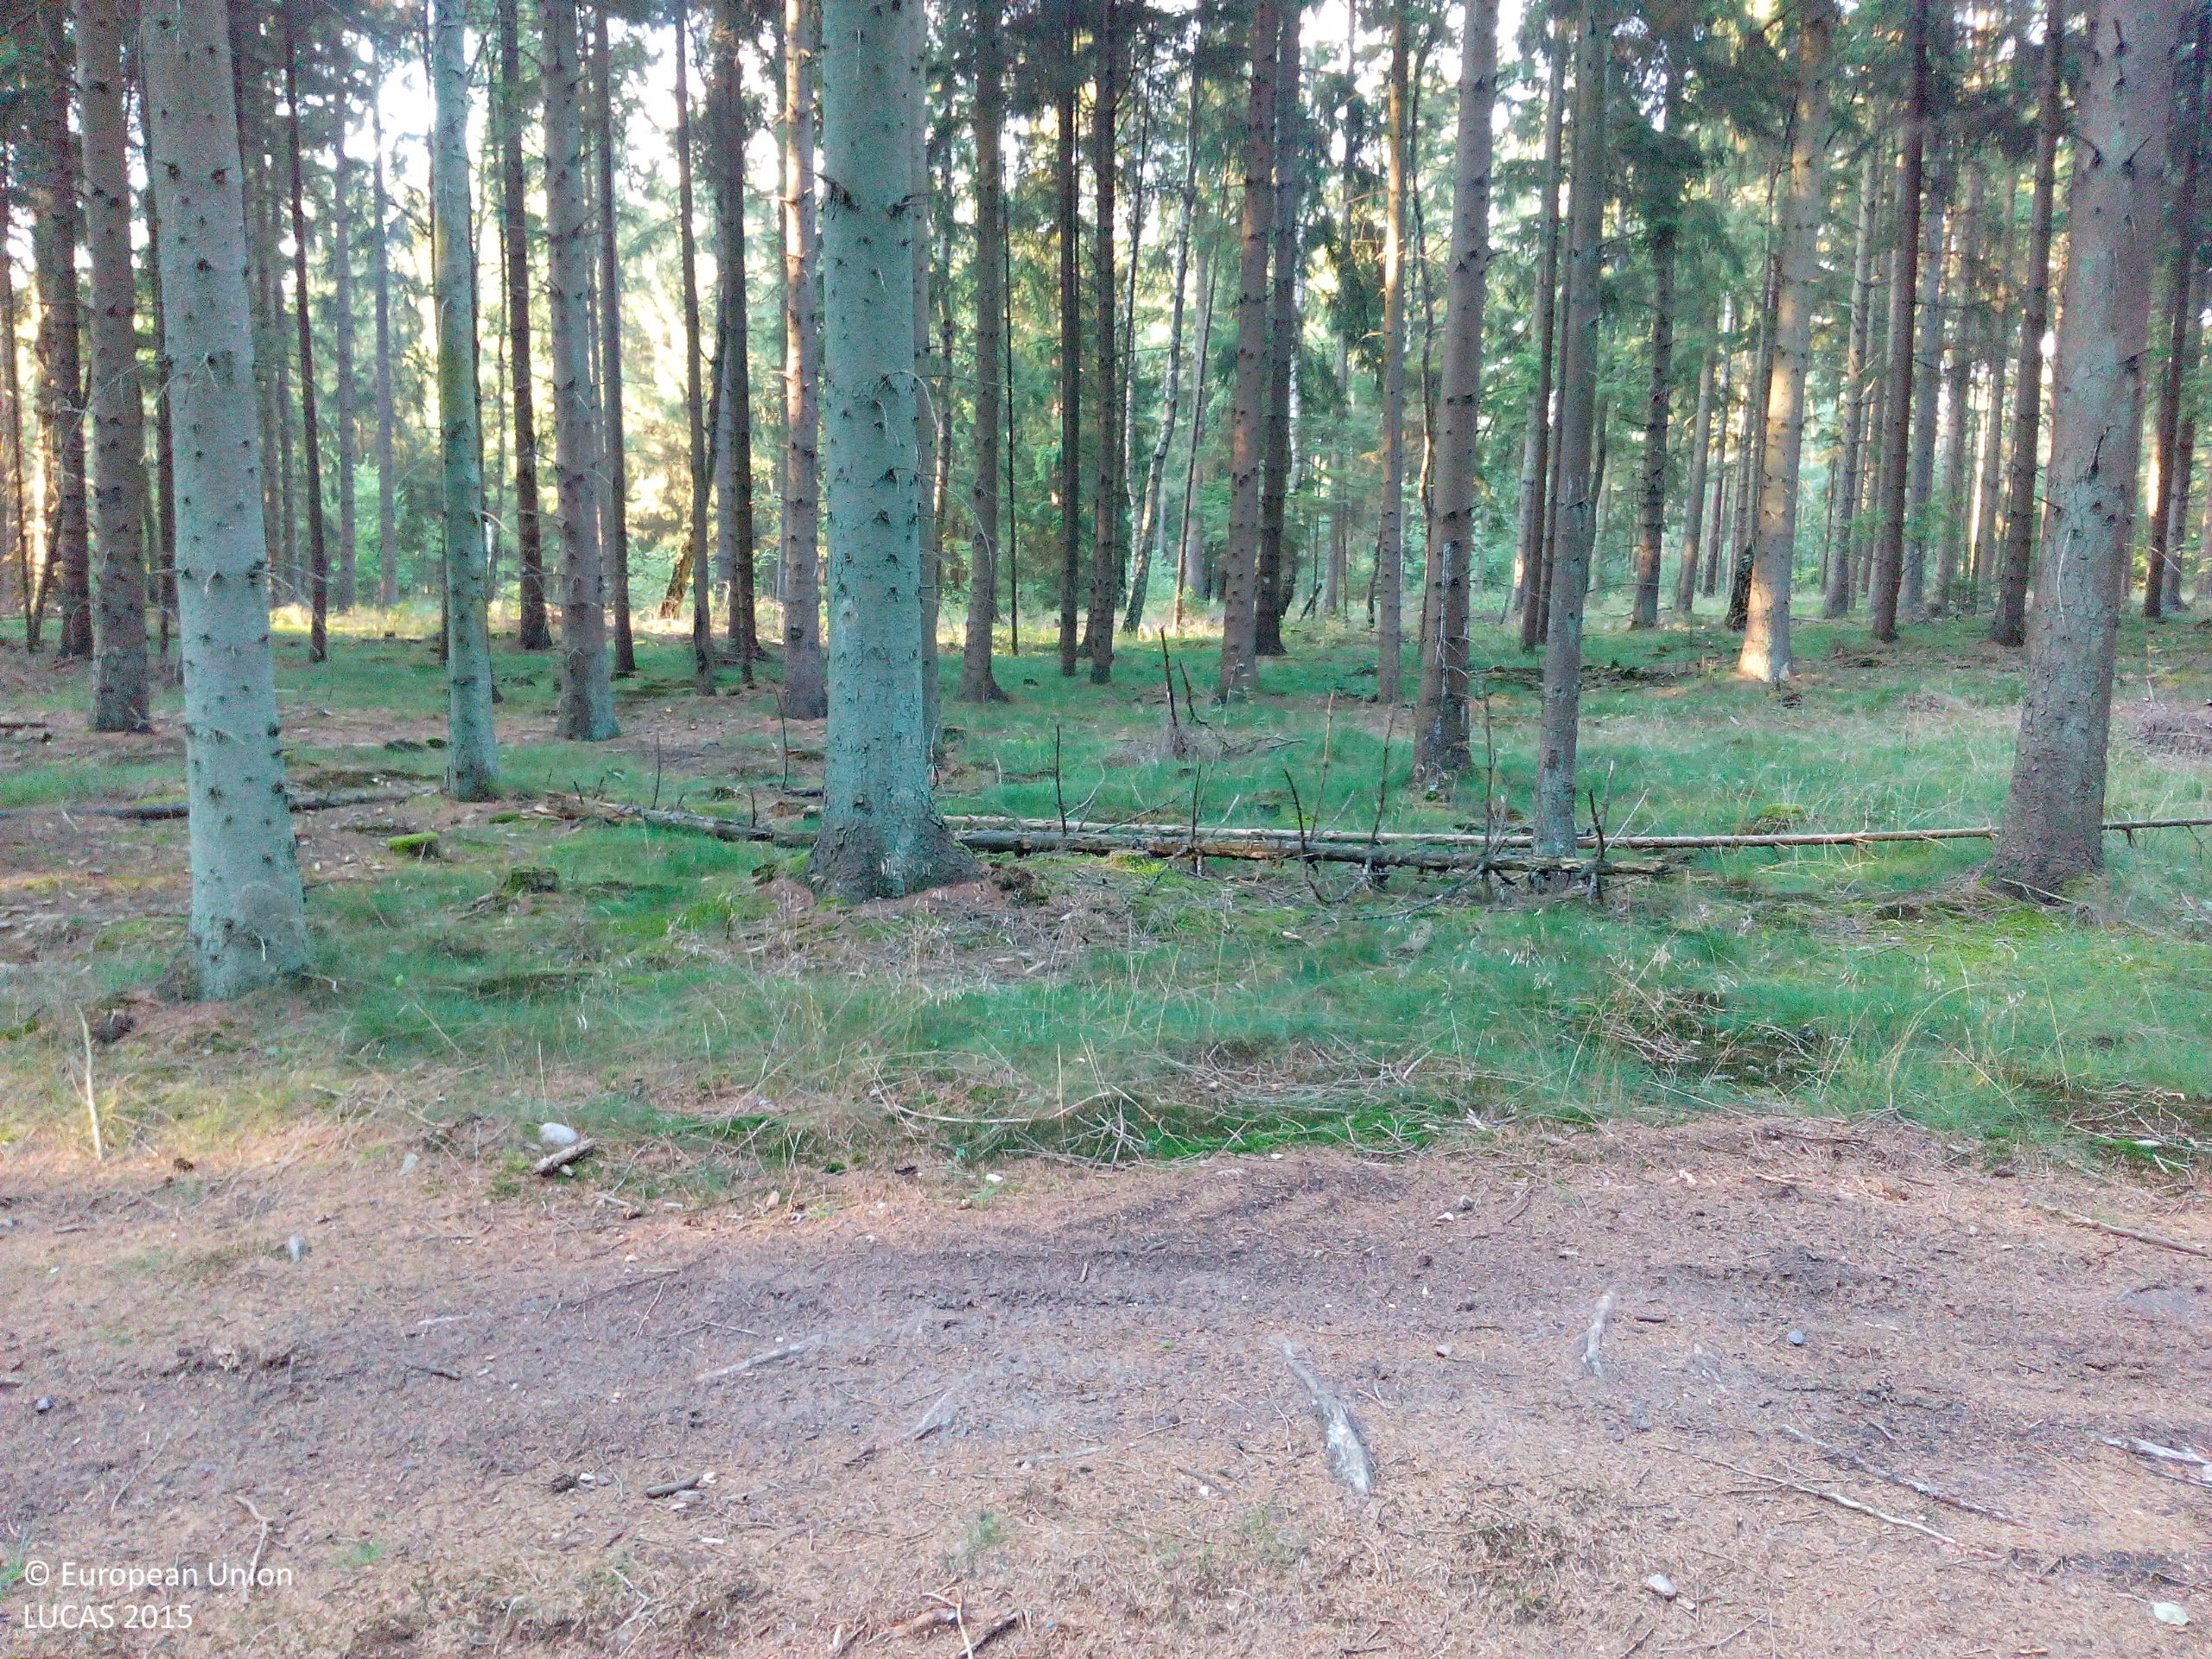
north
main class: Woodland
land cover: Spruce dominated coniferous woodland
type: hemiboreal forest and nemoral coniferous forest and mixed broadleaved-coniferous forest
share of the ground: > 75 %
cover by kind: coniferous forest trees 75 %, herbaceous plants 20 %, unconsolidated bare surface 5 %
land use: Forestry
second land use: Amenities, museums, leisure
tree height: > 5 m
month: August
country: DE
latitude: 53.8152
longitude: 9.8937
